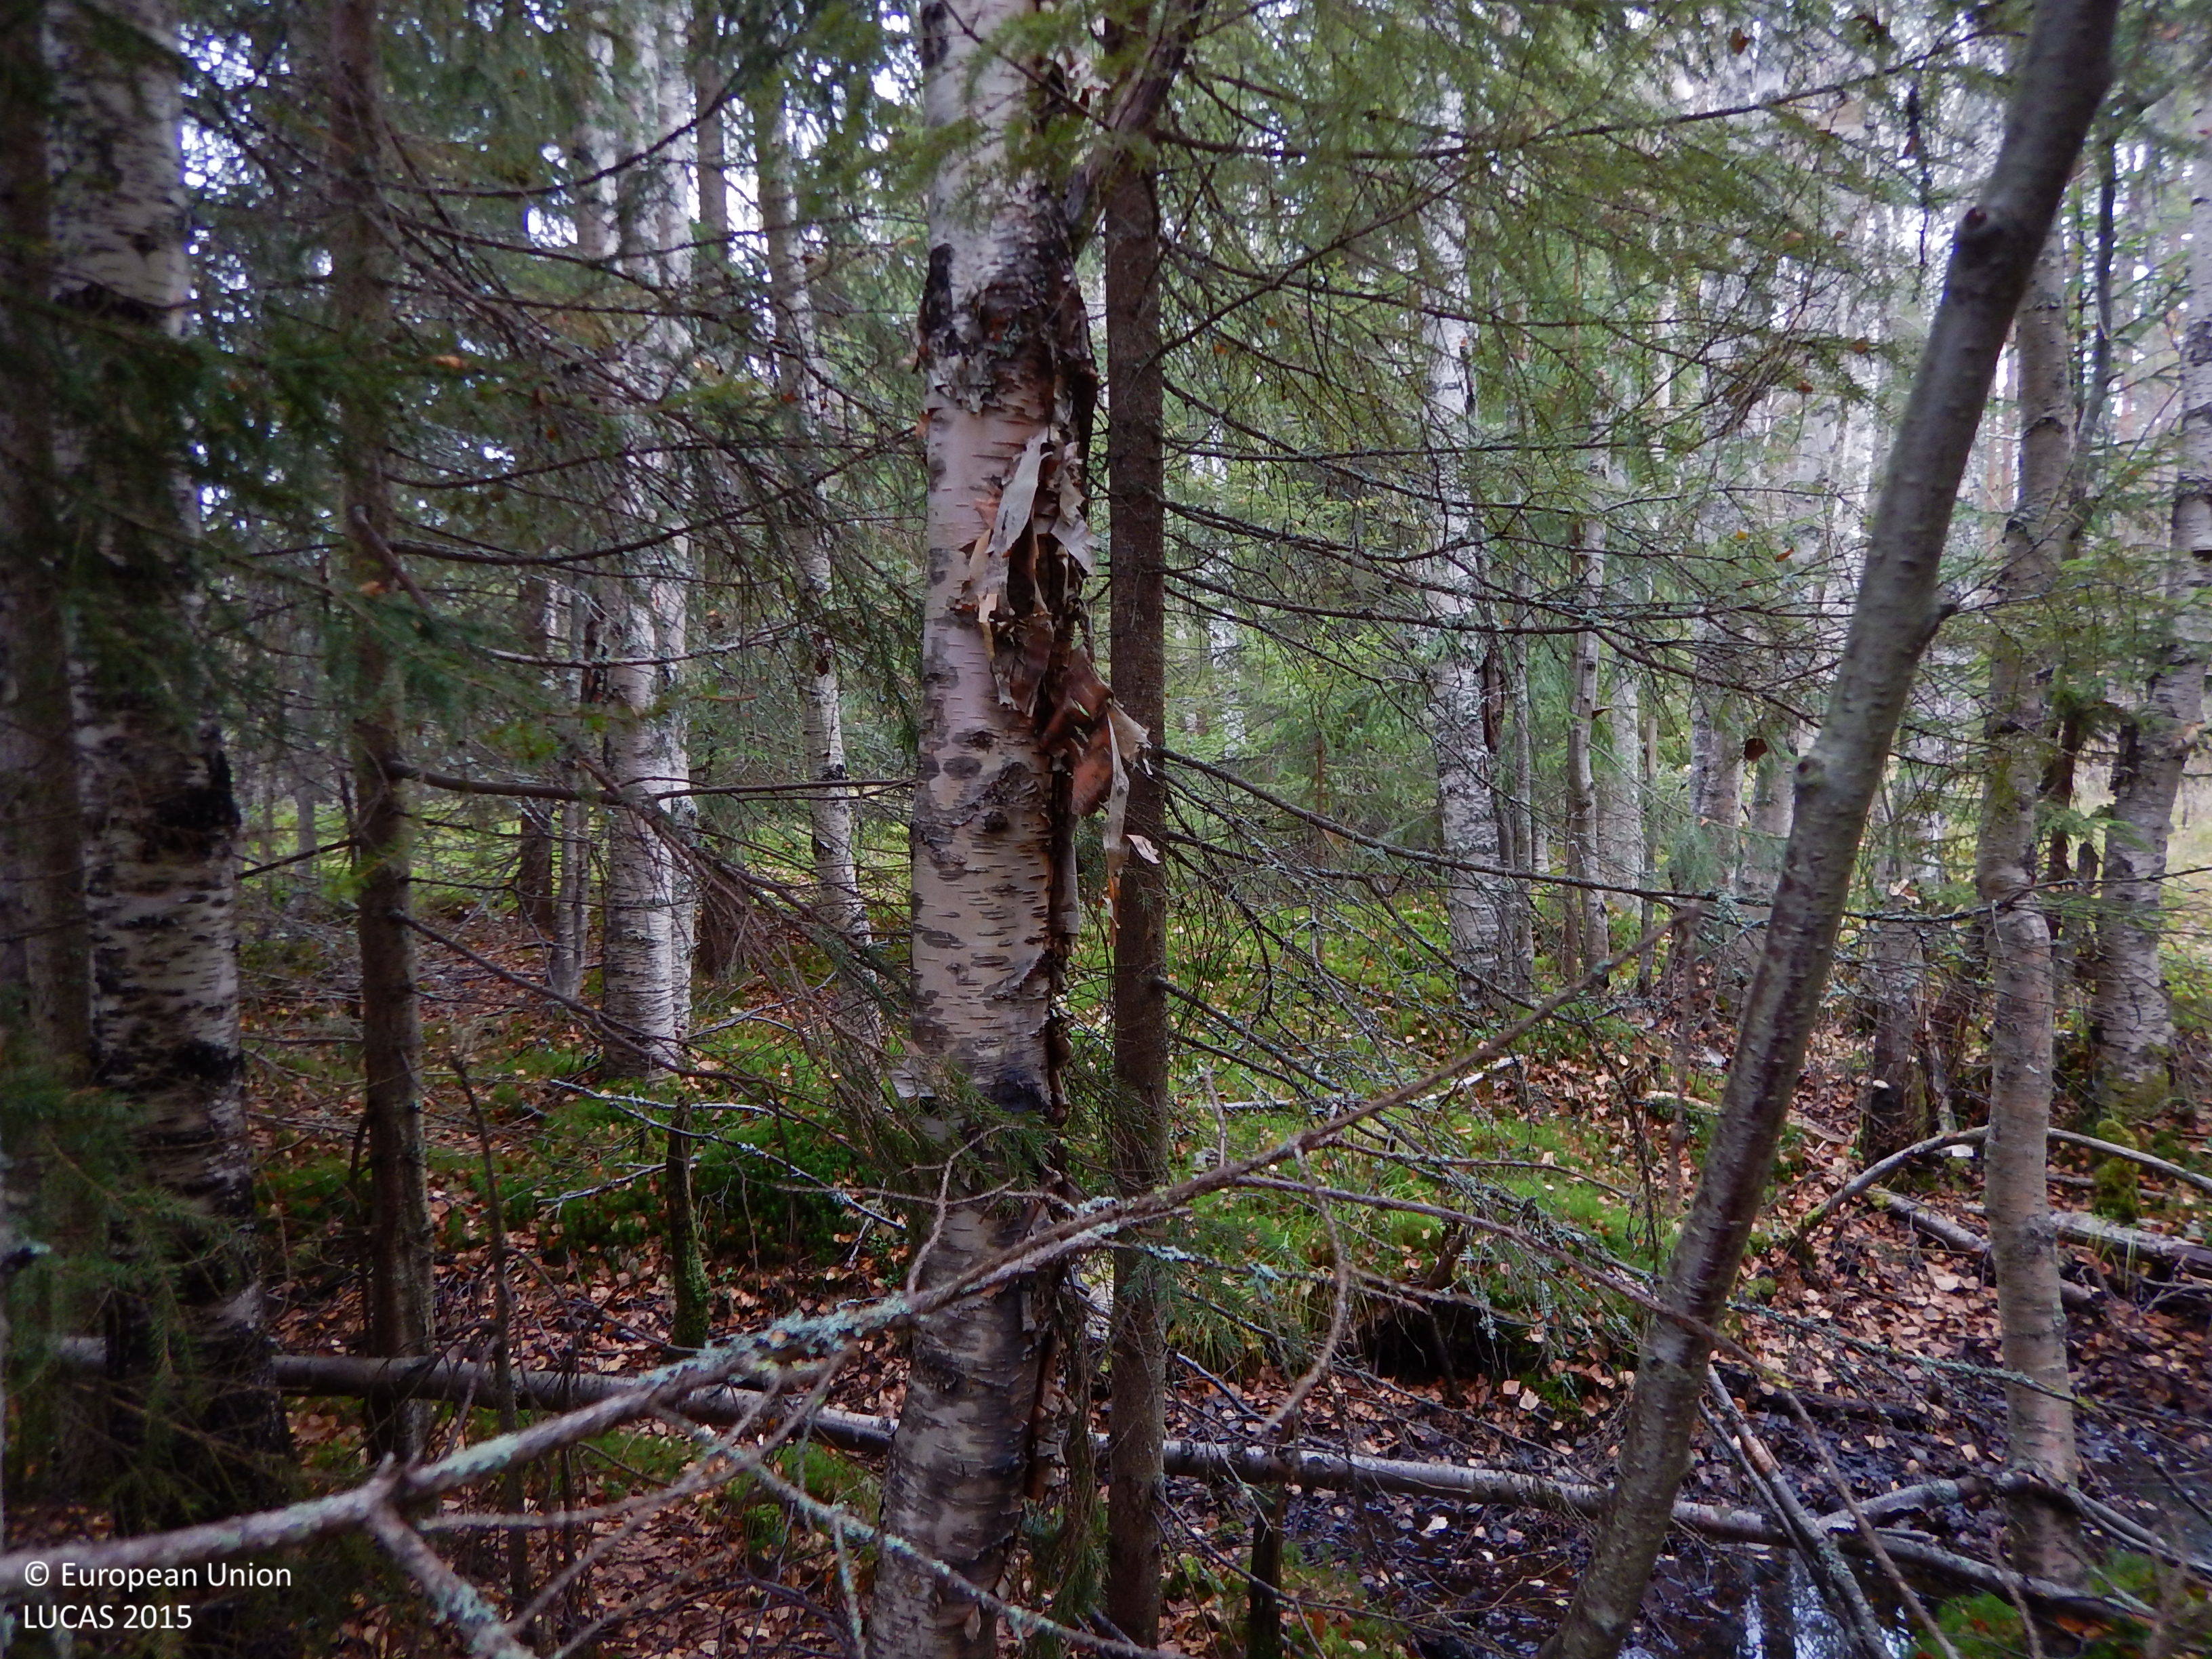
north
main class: Woodland
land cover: Spruce dominated mixed woodland
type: boreal forest
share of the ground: 50 - 75 %
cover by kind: coniferous forest trees 45 %, broadleaved forest trees 20 %, shrubs 15 %, herbaceous plants 15 %, lichens and mosses 5 %
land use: Forestry
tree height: > 5 m
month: October
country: SE
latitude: 65.1487
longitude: 21.5154
